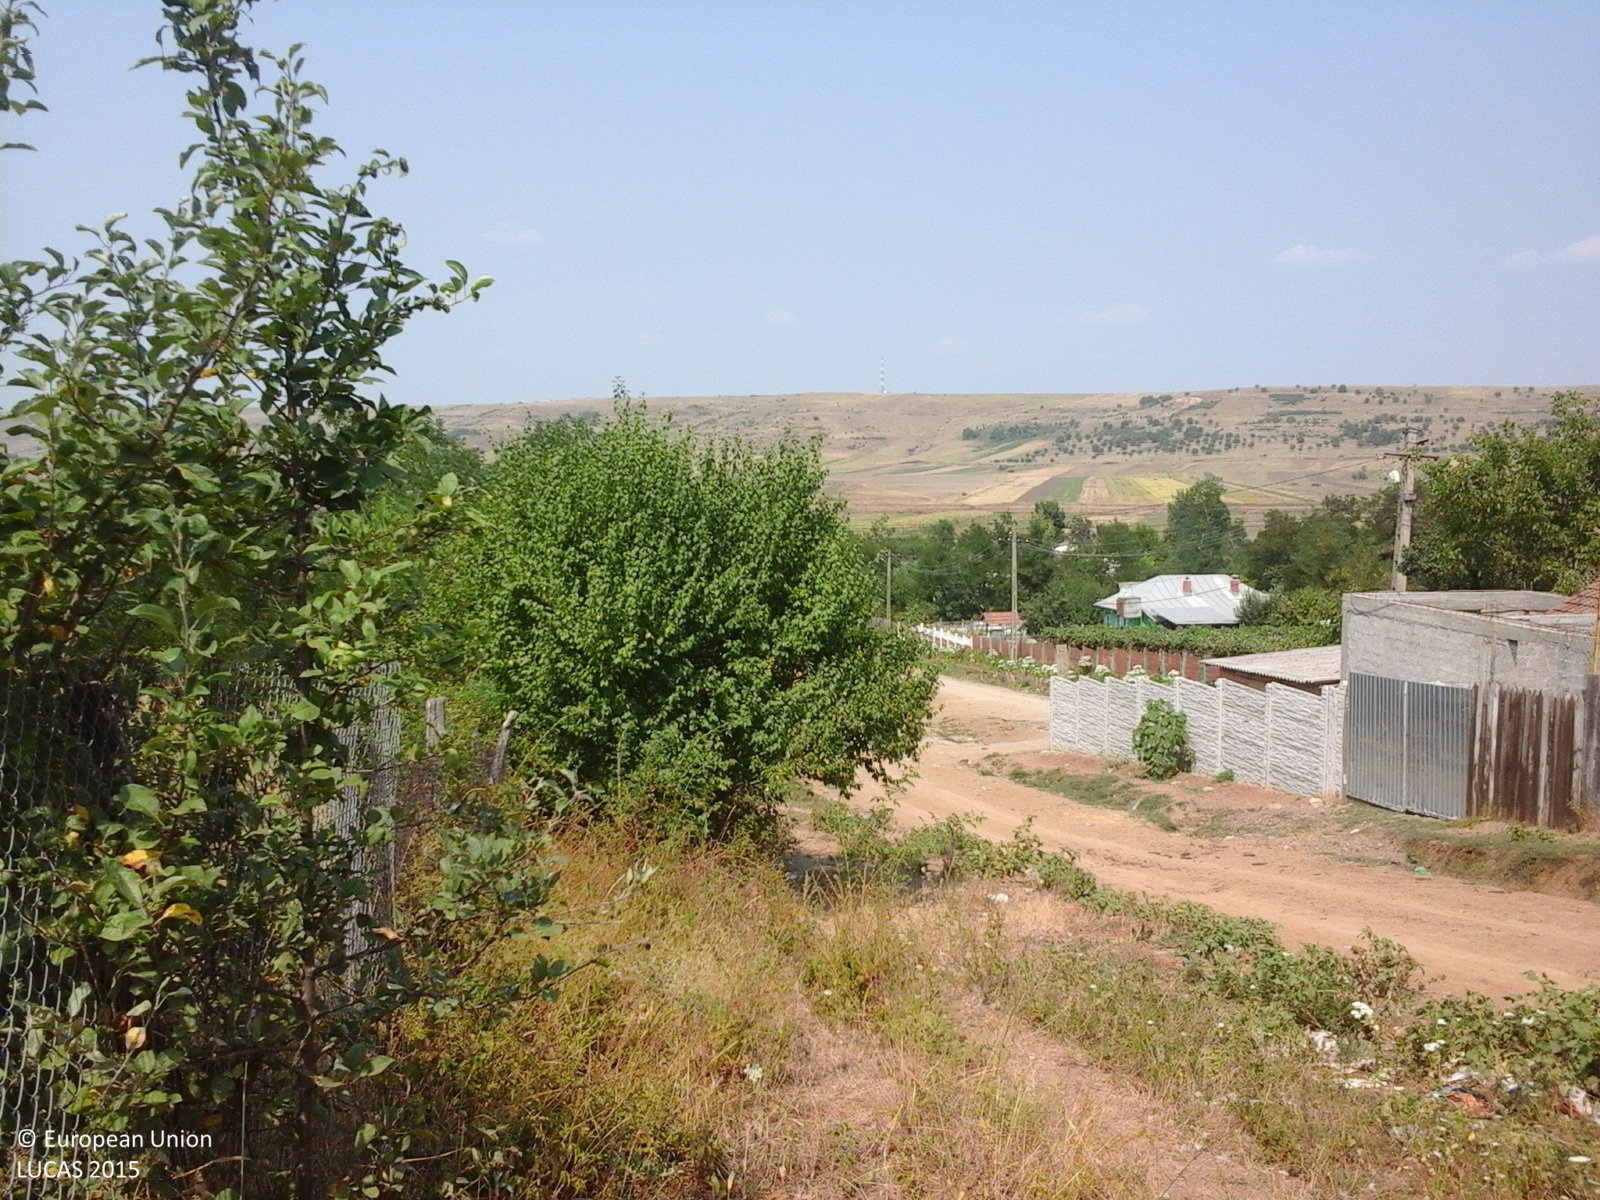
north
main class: Grassland
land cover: Grassland without tree/shrub cover
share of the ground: > 75 %
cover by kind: herbaceous plants 100 %
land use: Agriculture (excluding fallow land and kitchen gardens)
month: August
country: RO
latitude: 44.3615
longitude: 23.6177
